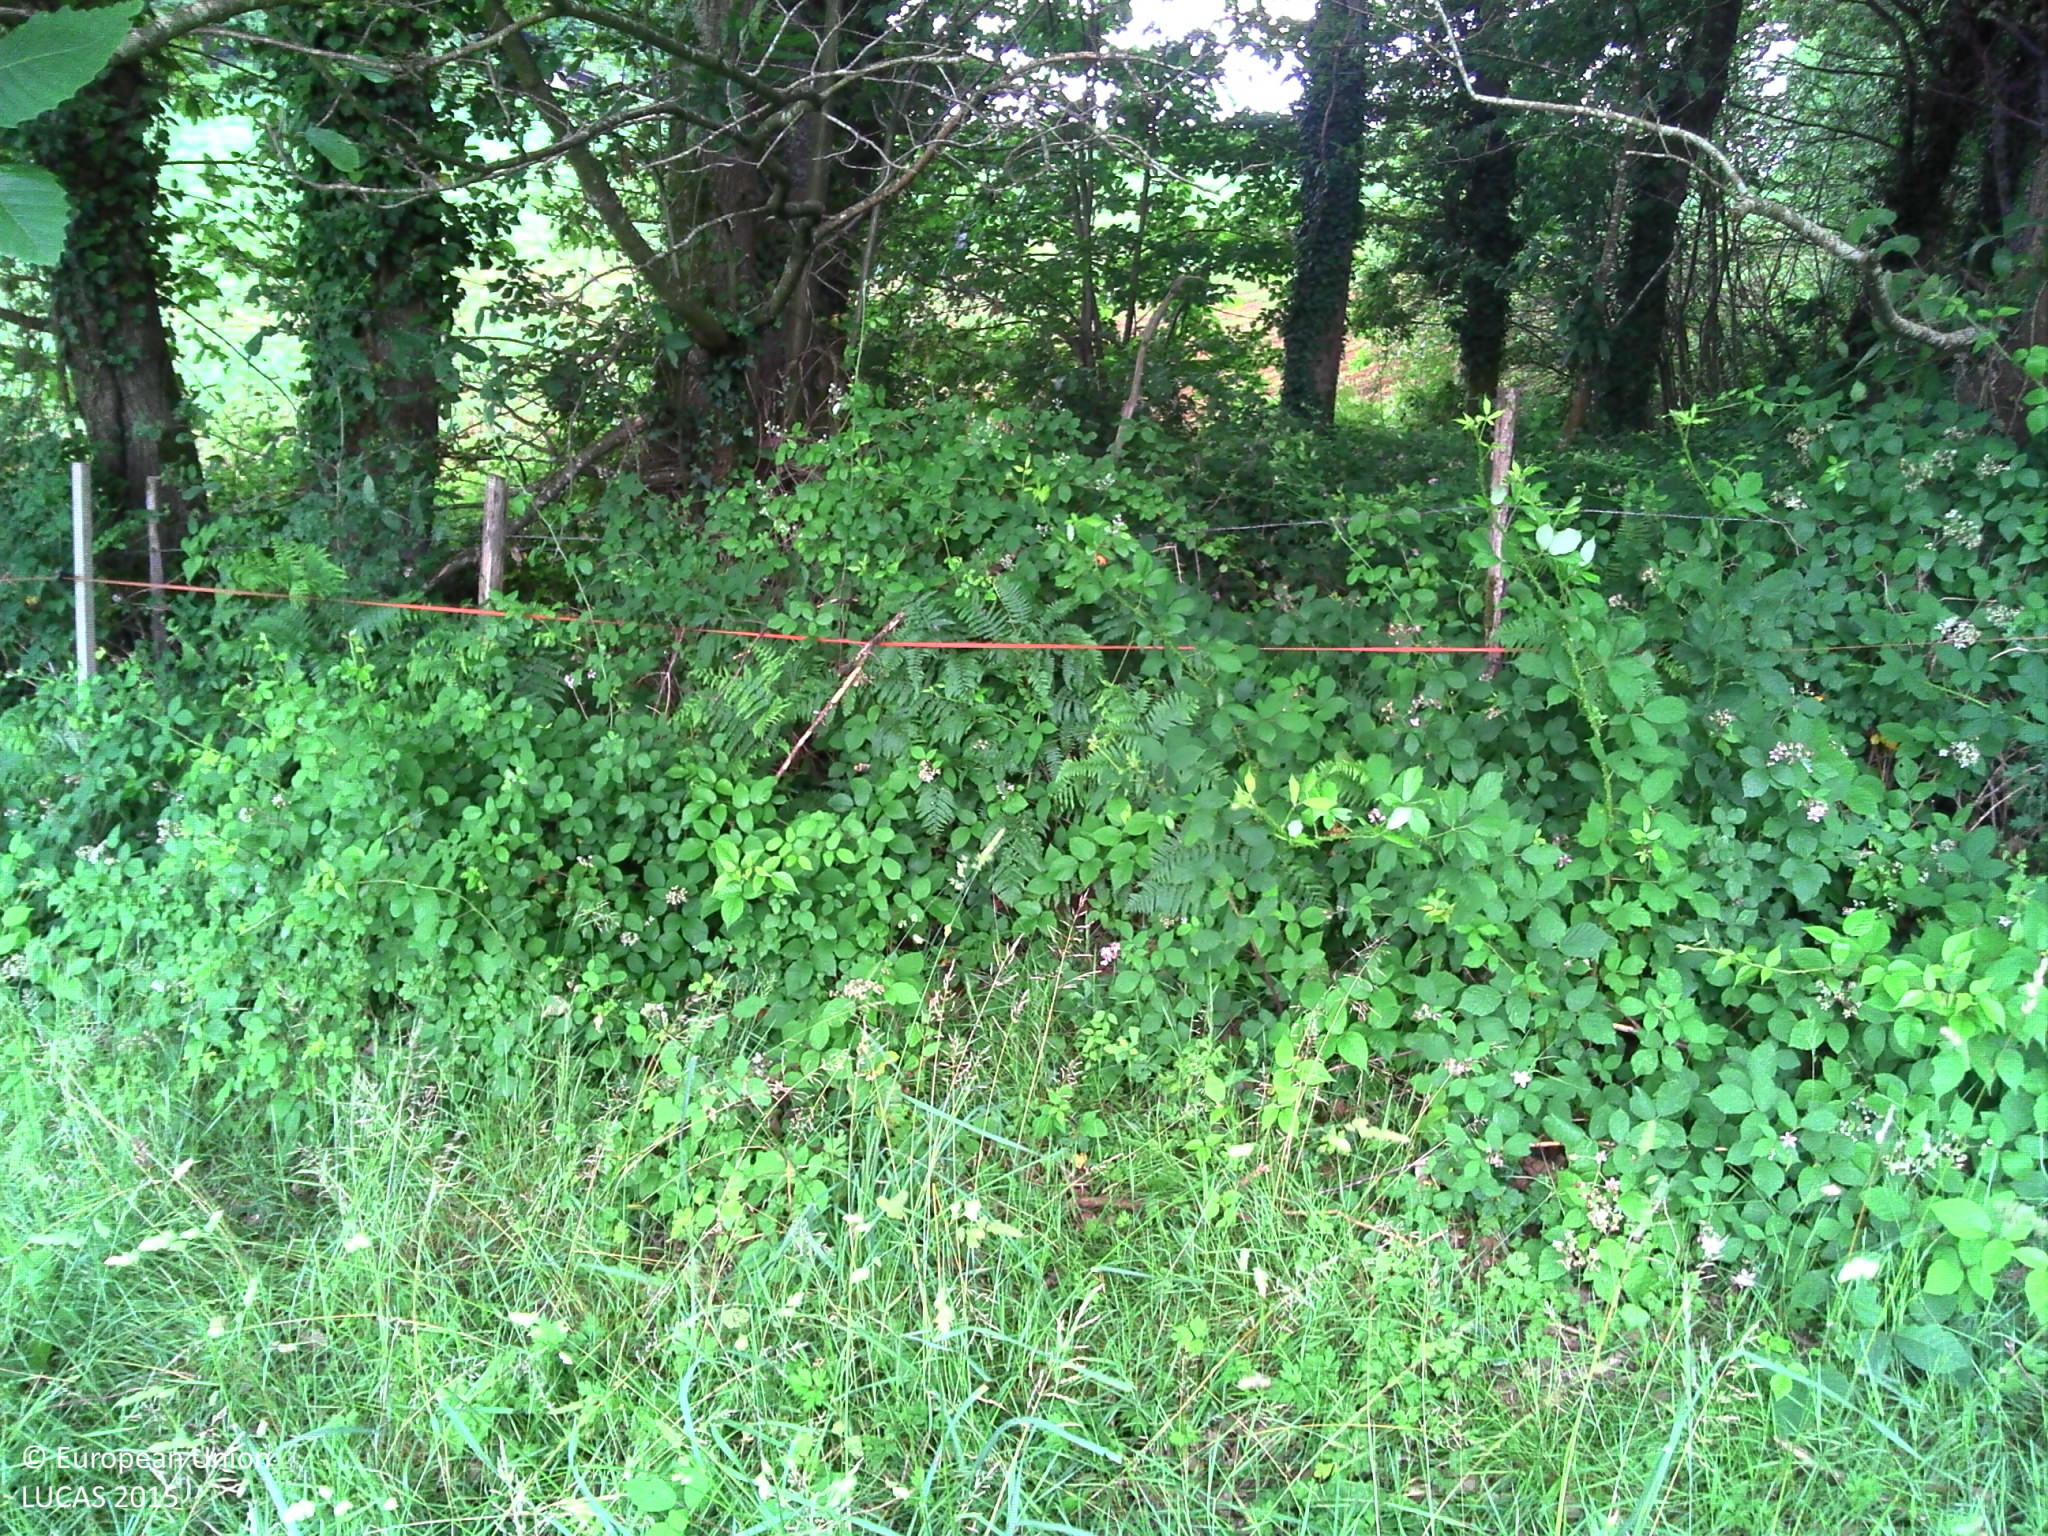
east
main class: Grassland
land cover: Grassland without tree/shrub cover
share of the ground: > 75 %
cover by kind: herbaceous plants 100 %
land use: Agriculture (excluding fallow land and kitchen gardens)
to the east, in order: Grassland without tree/shrub cover; Fences; Broadleaved woodland; Maize; Managed hedges; Tracks; Managed hedges; Soya; Fences; Spontaneously vegetated surfaces
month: June
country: FR
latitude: 43.3024
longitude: -0.7222
